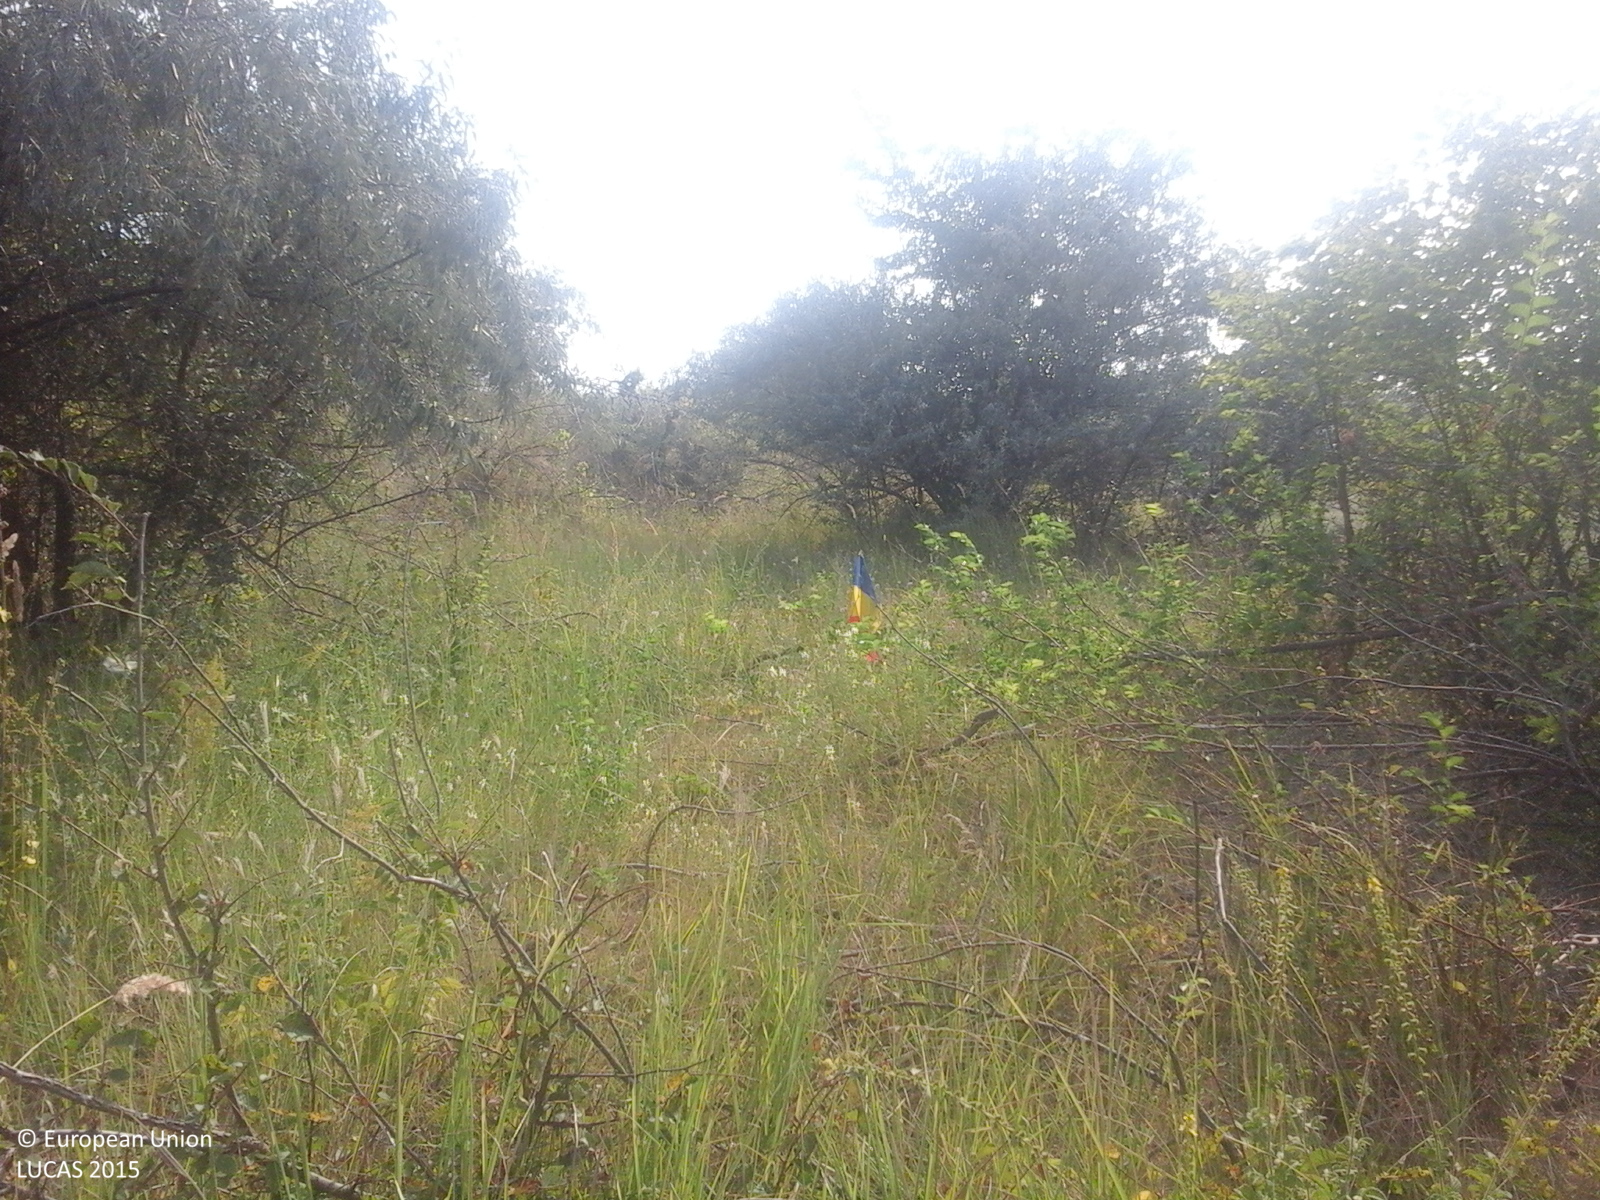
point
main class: Grassland
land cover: Grassland with sparse tree/shrub cover
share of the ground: > 75 %
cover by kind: herbaceous plants 85 %, shrubs 10 %, broadleaved forest trees 5 %
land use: Agriculture (excluding fallow land and kitchen gardens)
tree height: < 5 m
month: July
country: RO
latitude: 45.2647
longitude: 28.3384
